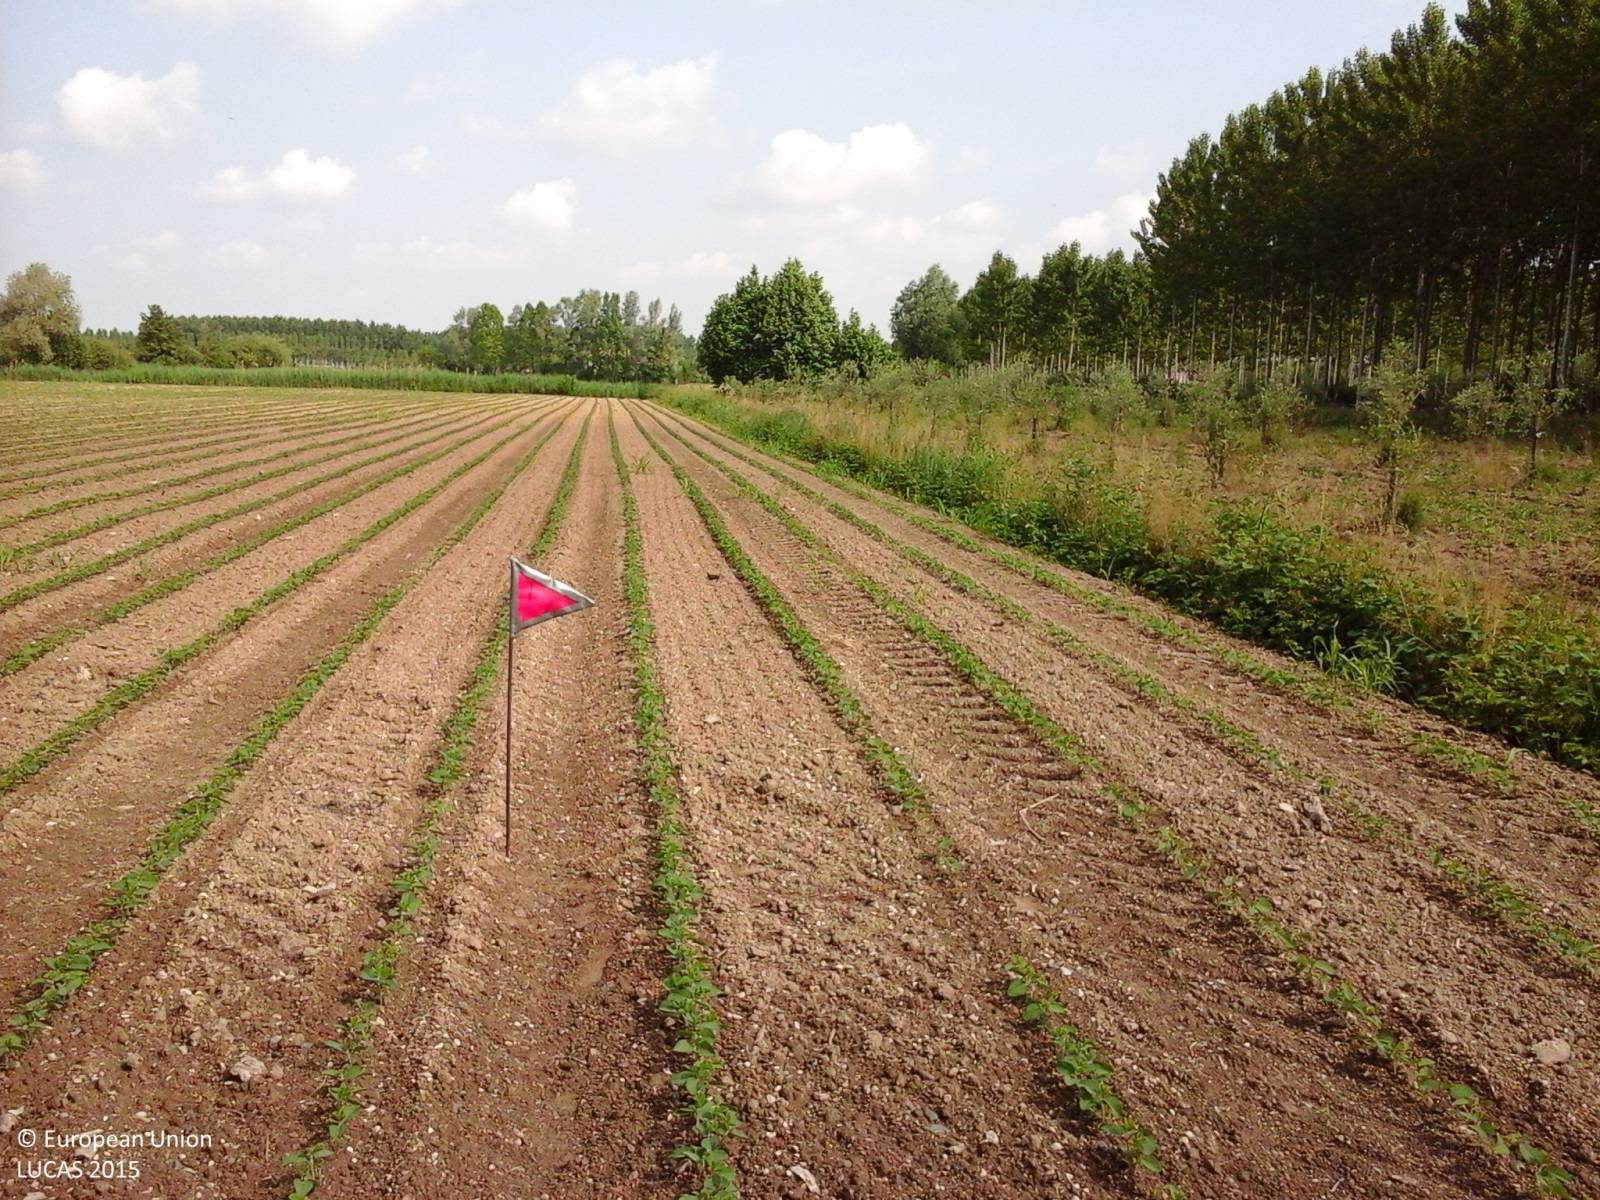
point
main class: Cropland
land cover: Soya
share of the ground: < 10 %
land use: Agriculture (excluding fallow land and kitchen gardens)
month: May
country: IT
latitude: 45.8526
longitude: 13.2028
